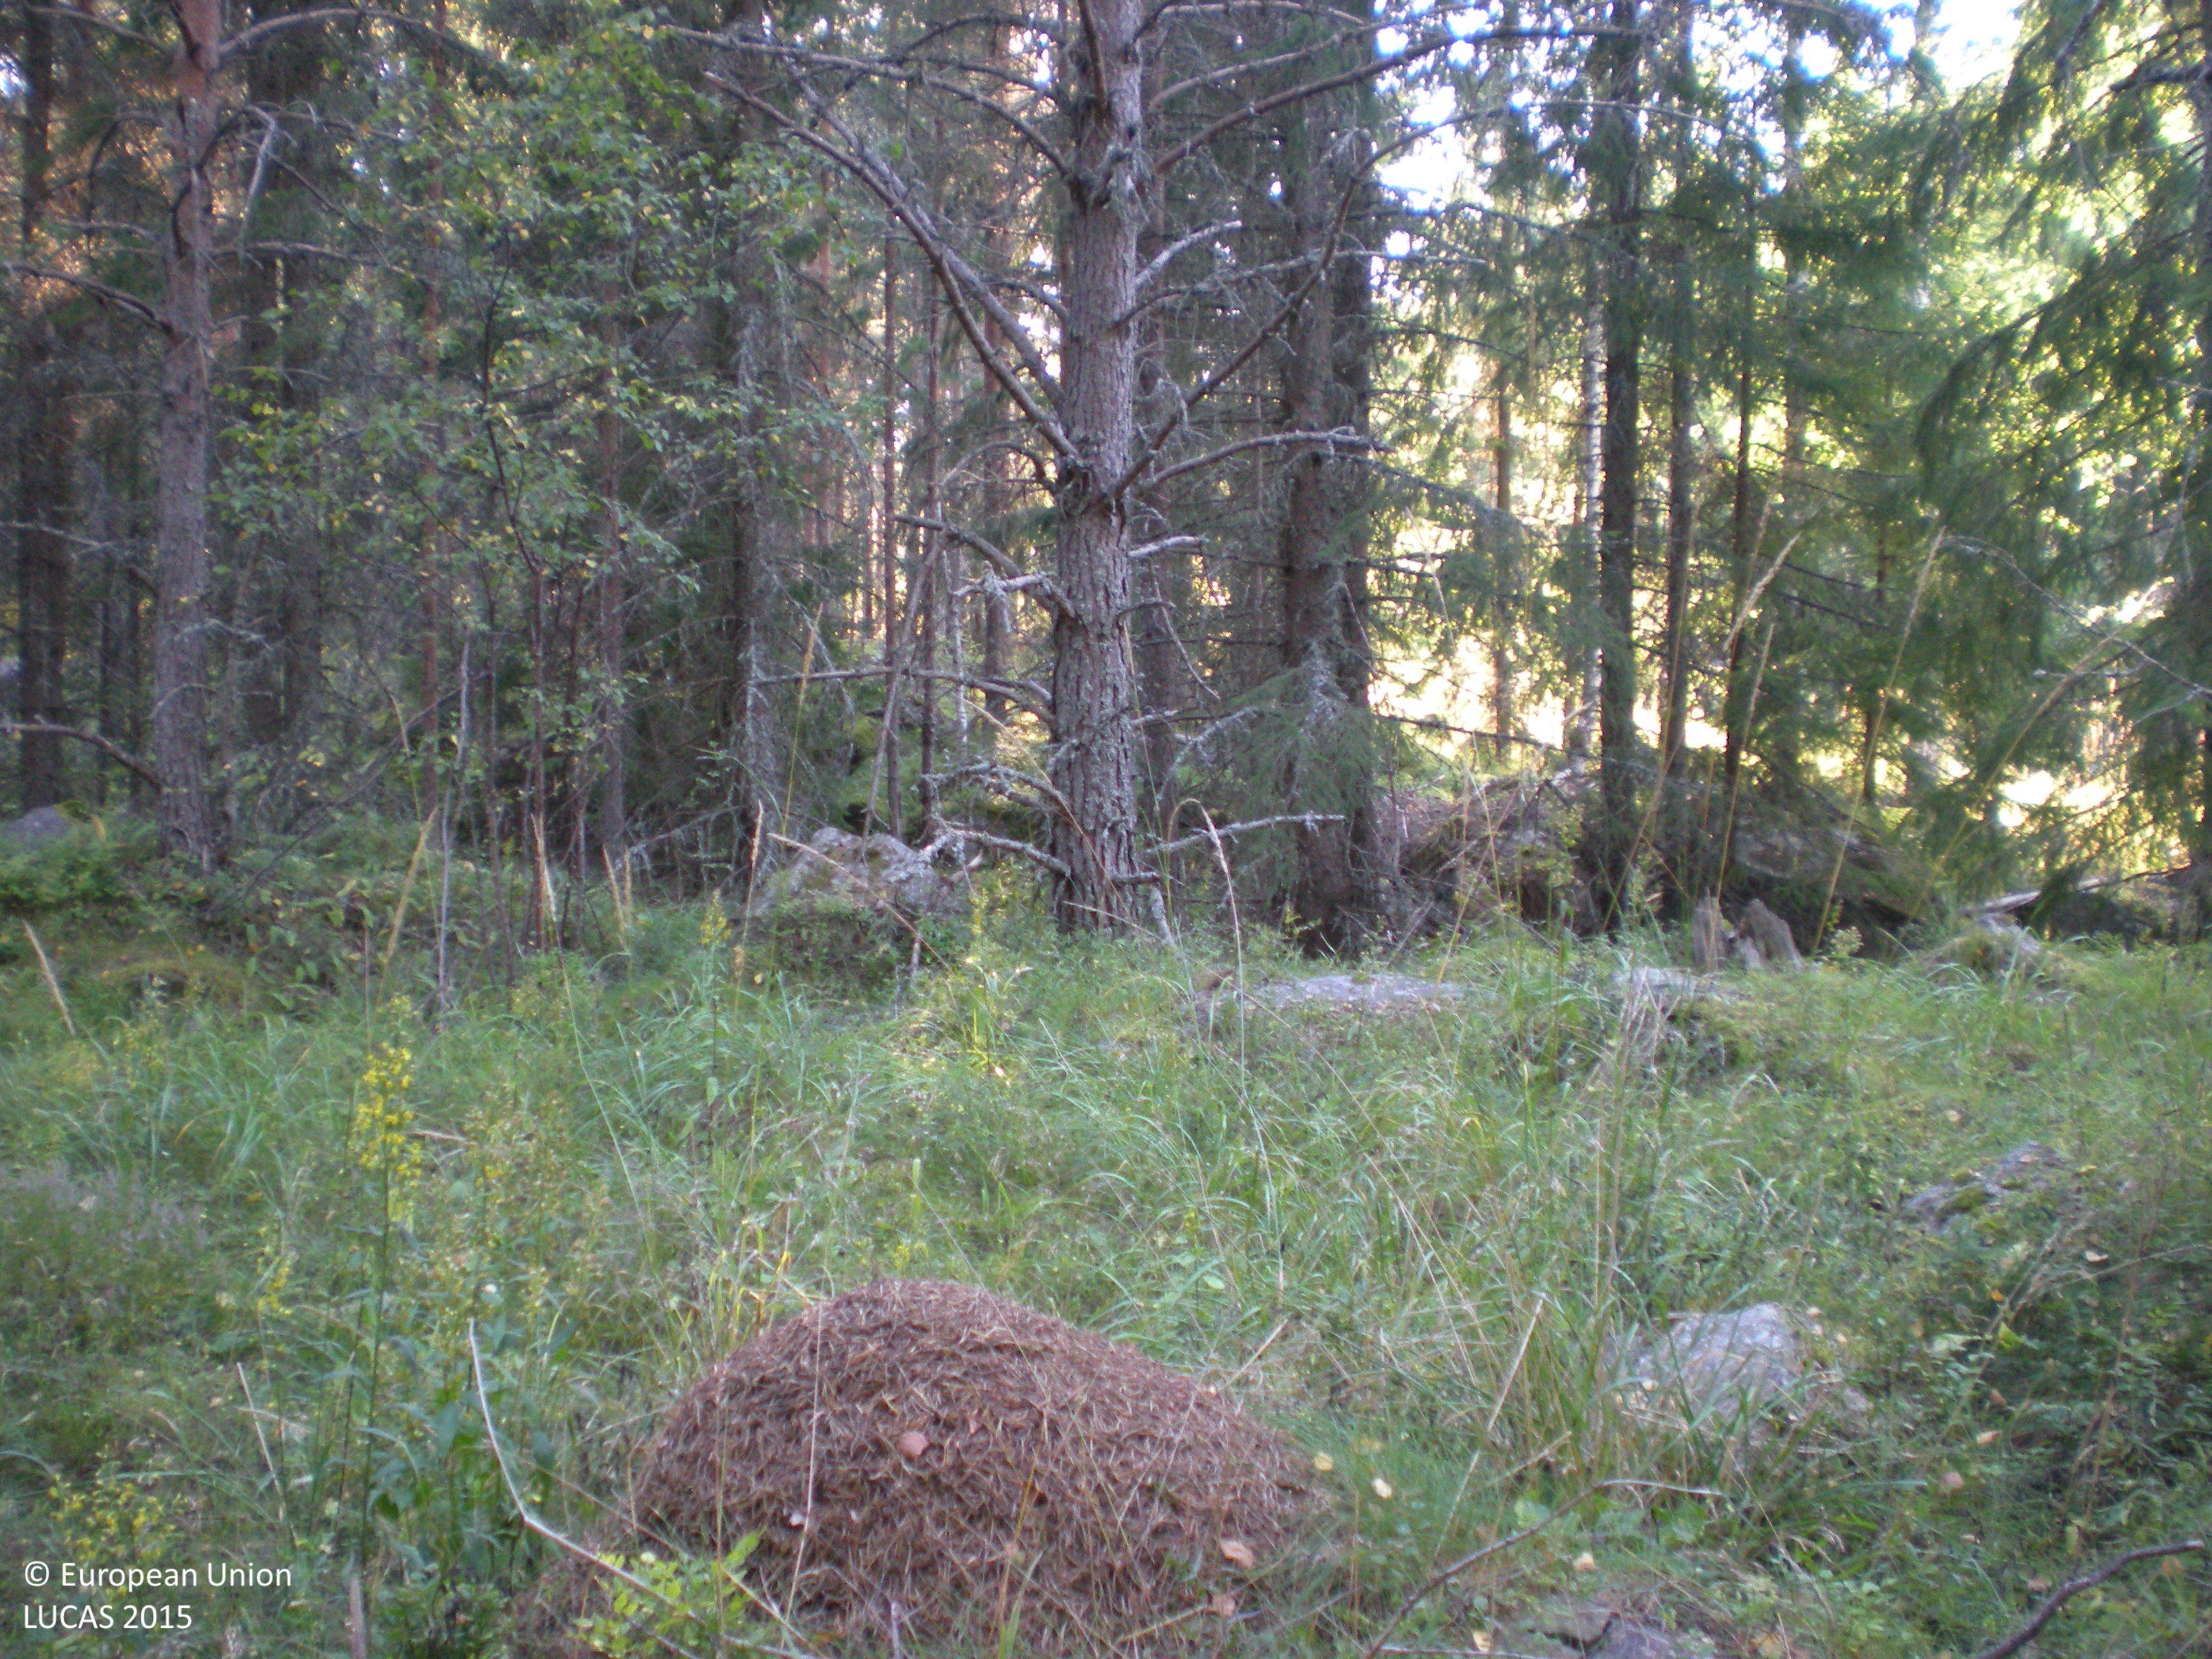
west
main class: Woodland
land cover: Pine dominated coniferous woodland
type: boreal forest
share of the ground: 50 - 75 %
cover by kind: coniferous forest trees 60 %, herbaceous plants 15 %, broadleaved forest trees 10 %, shrubs 10 %, lichens and mosses 5 %
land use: Forestry
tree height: > 5 m
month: August
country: SE
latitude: 60.6059
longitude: 17.3141
